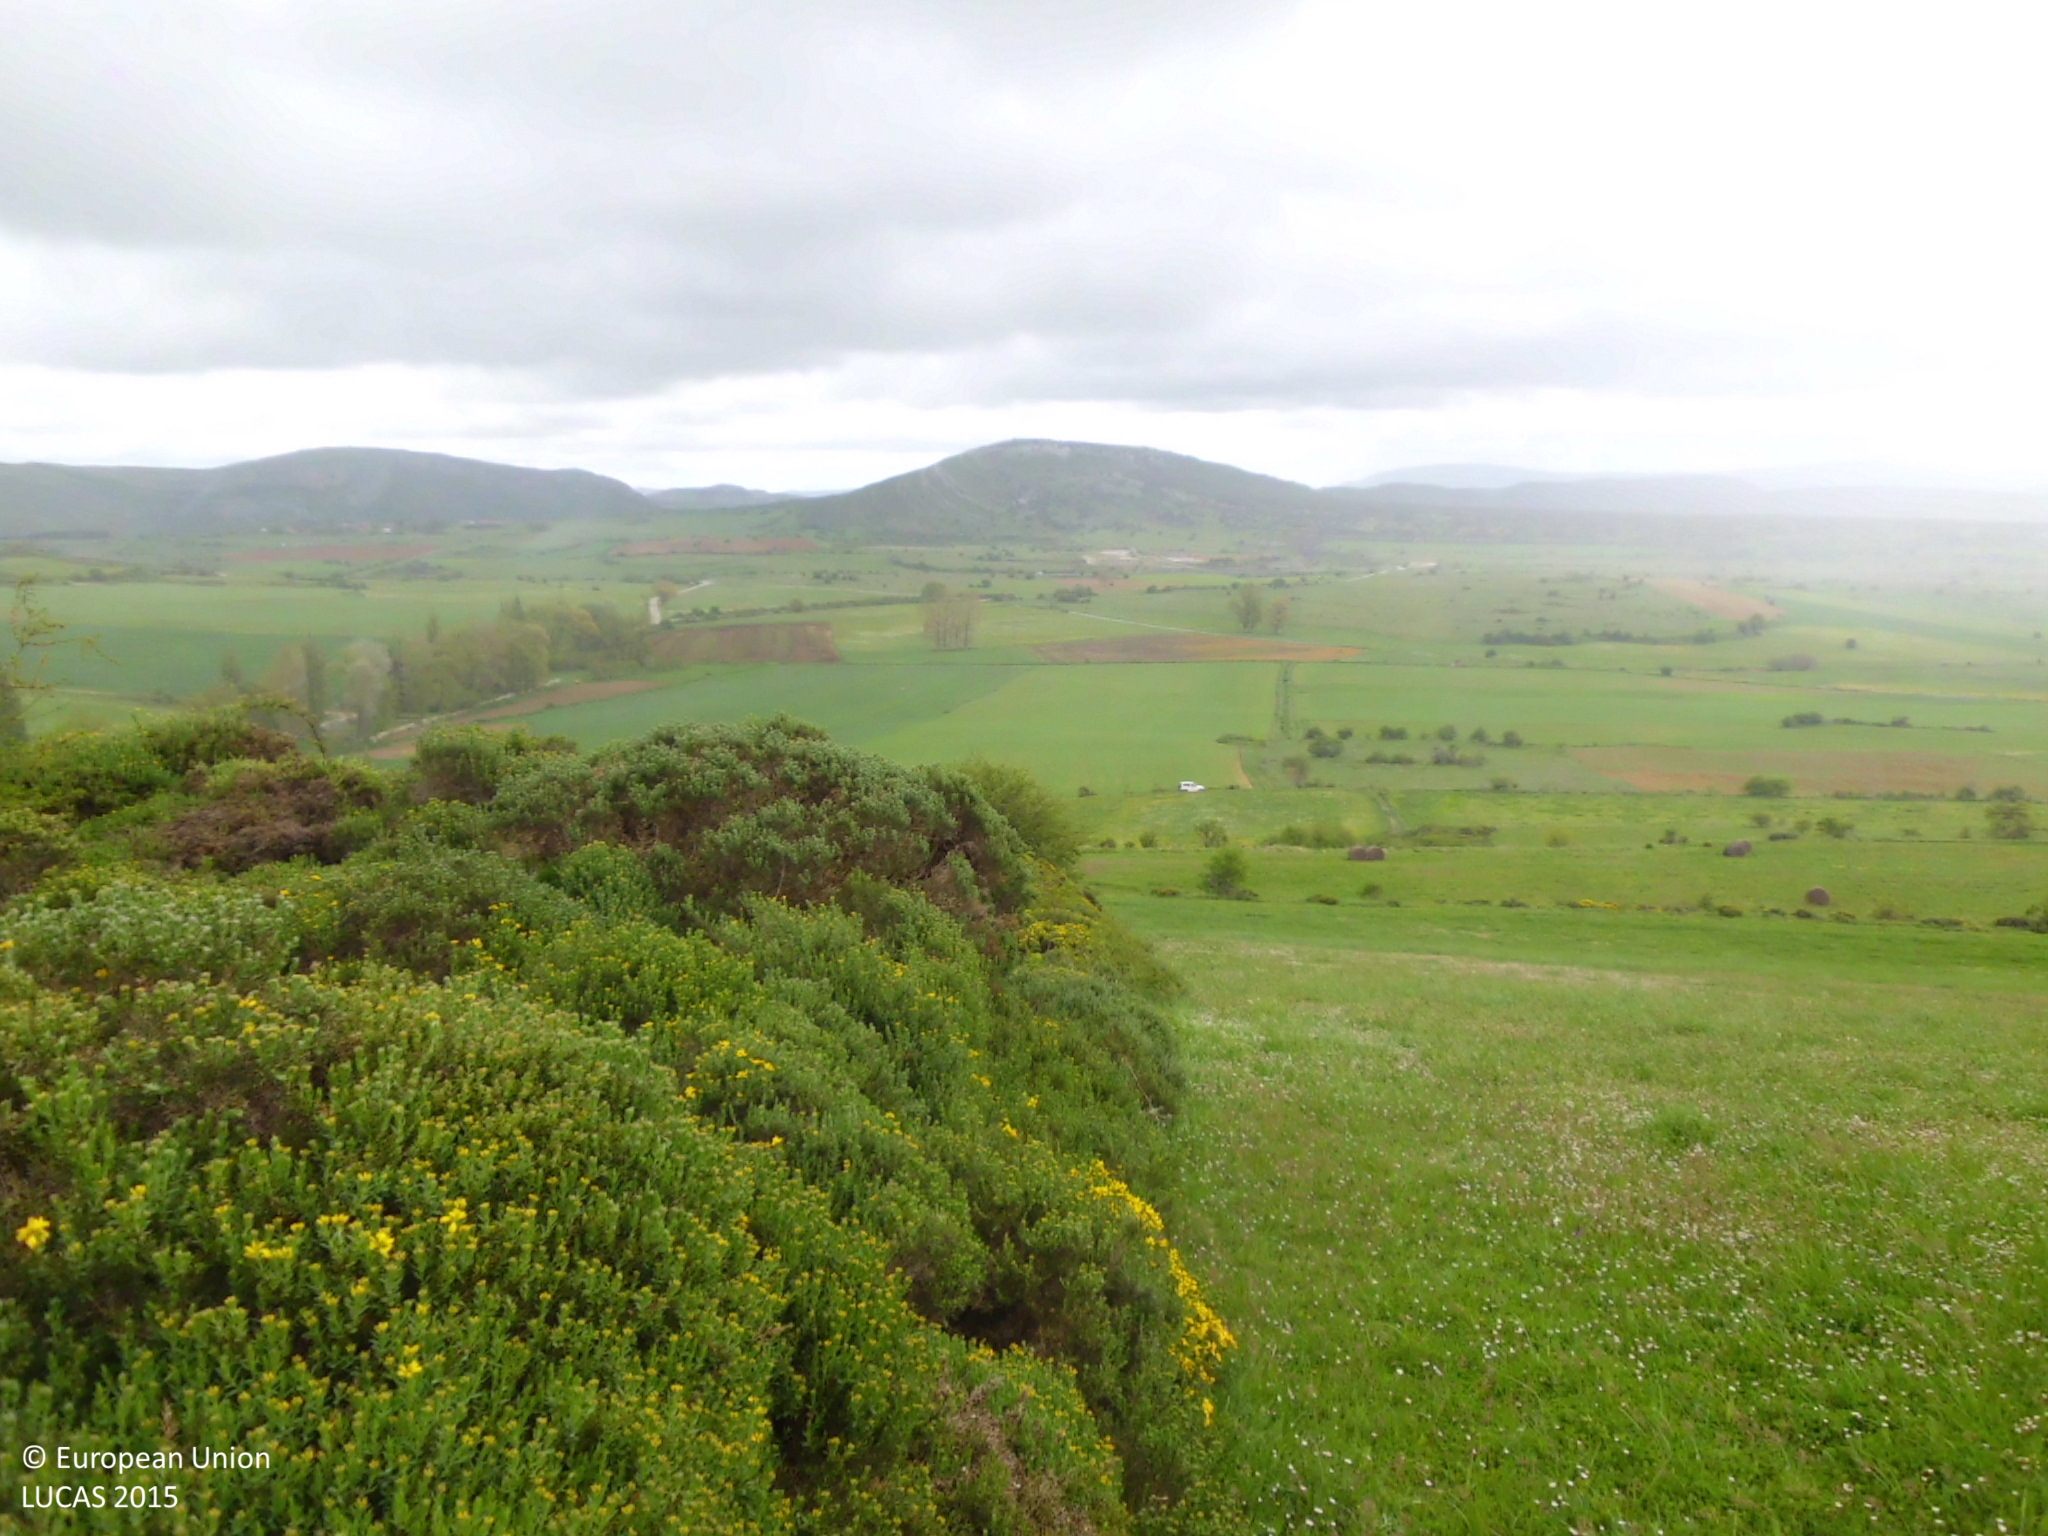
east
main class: Shrubland
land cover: Shrubland without tree cover
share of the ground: > 75 %
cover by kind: shrubs 80 %, herbaceous plants 20 %
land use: Semi-natural and natural areas not in use
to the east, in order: Shrubland without tree cover; Spontaneously vegetated surfaces; Tracks; Spontaneously vegetated surfaces; Tracks; Grassland with sparse tree/shrub cover; Barley
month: May
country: ES
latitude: 42.9050
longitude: -3.8477
